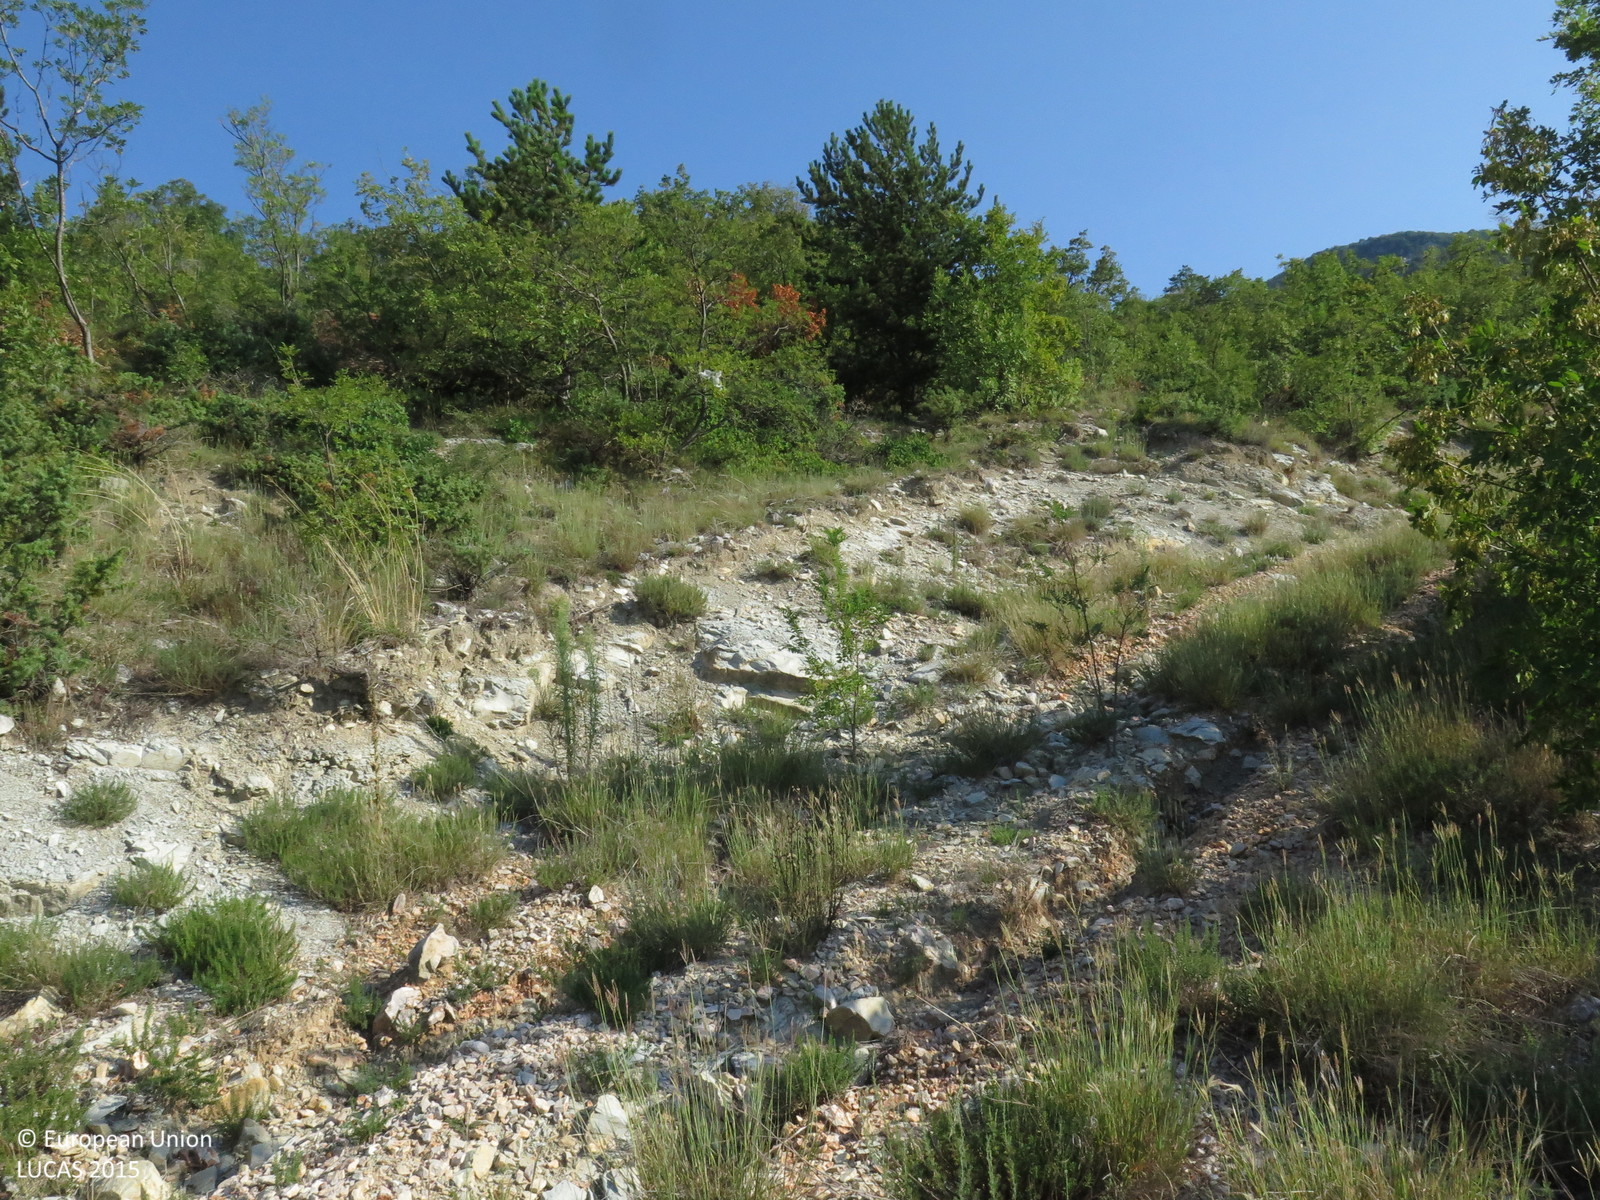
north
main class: Shrubland
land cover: Shrubland with sparse tree cover
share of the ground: 50 - 75 %
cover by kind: shrubs 60 %, herbaceous plants 15 %, unconsolidated bare surface 15 %, broadleaved forest trees 5 %, lichens and mosses 5 %
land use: Semi-natural and natural areas not in use
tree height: < 5 m
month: August
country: HR
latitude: 45.2195
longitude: 14.6938
